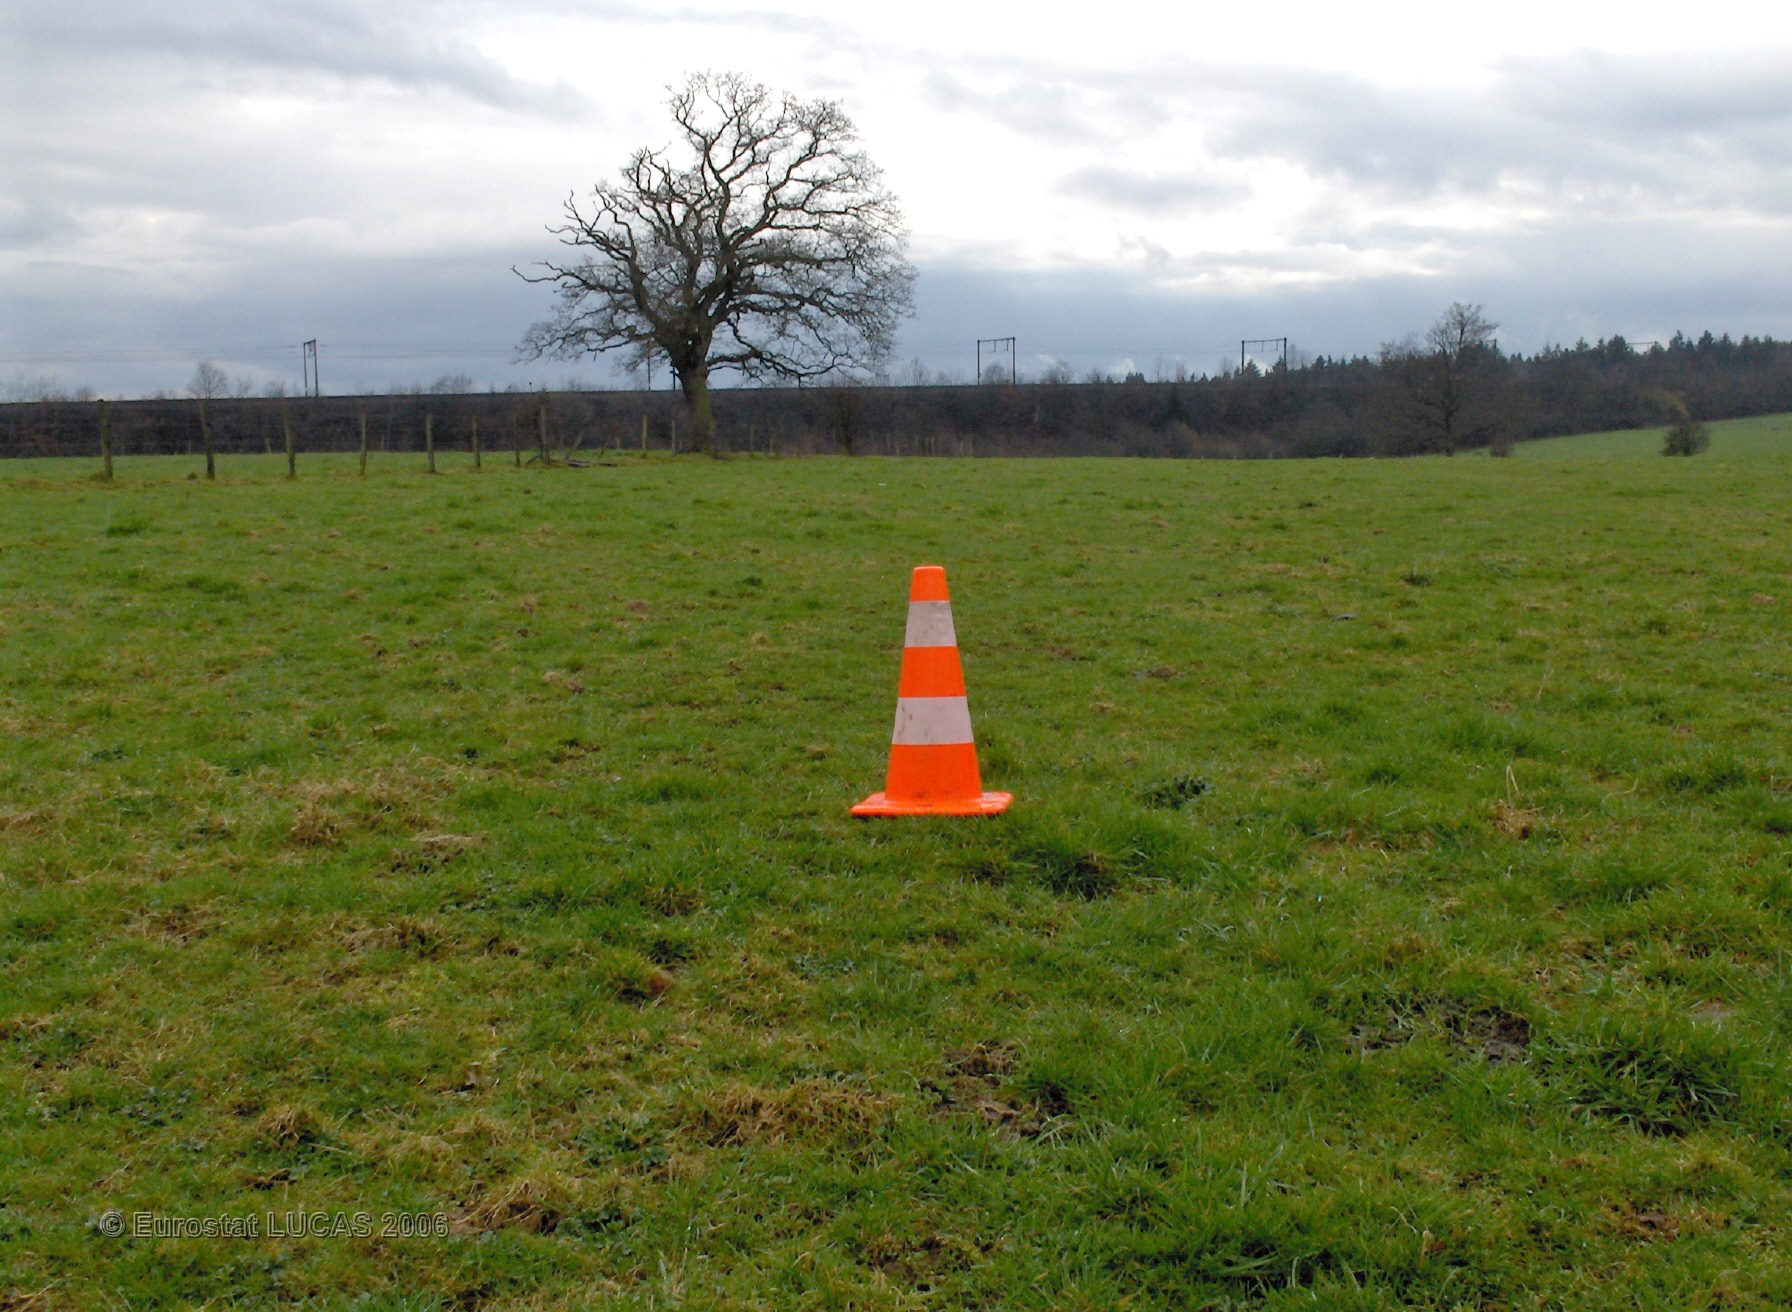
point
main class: Grassland
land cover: Grassland without tree/shrub cover
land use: Agriculture (excluding fallow land and kitchen gardens)
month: April
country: BE
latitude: 50.2483
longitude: 5.2718
